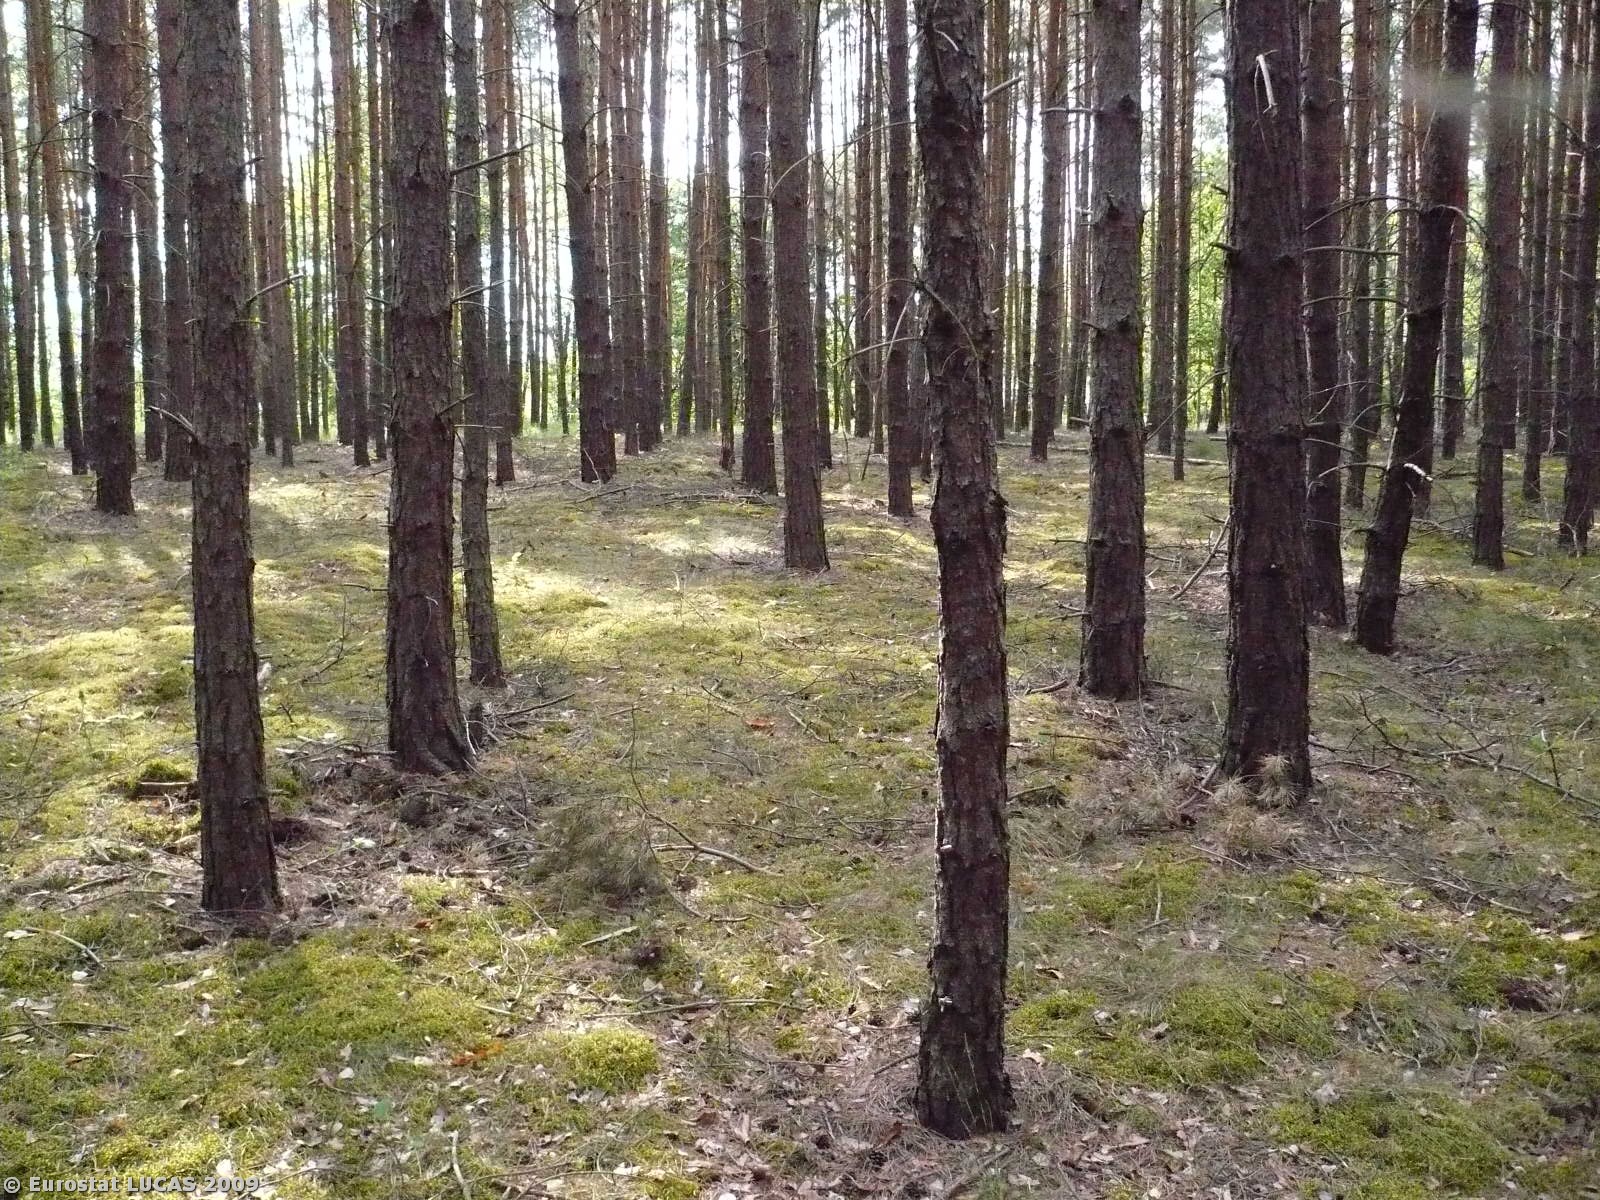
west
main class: Woodland
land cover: Coniferous woodland
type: hemiboreal forest and nemoral coniferous forest and mixed broadleaved-coniferous forest
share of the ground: > 75 %
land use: Forestry
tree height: > 5 m
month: May
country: PL
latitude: 52.0598
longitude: 15.3272
